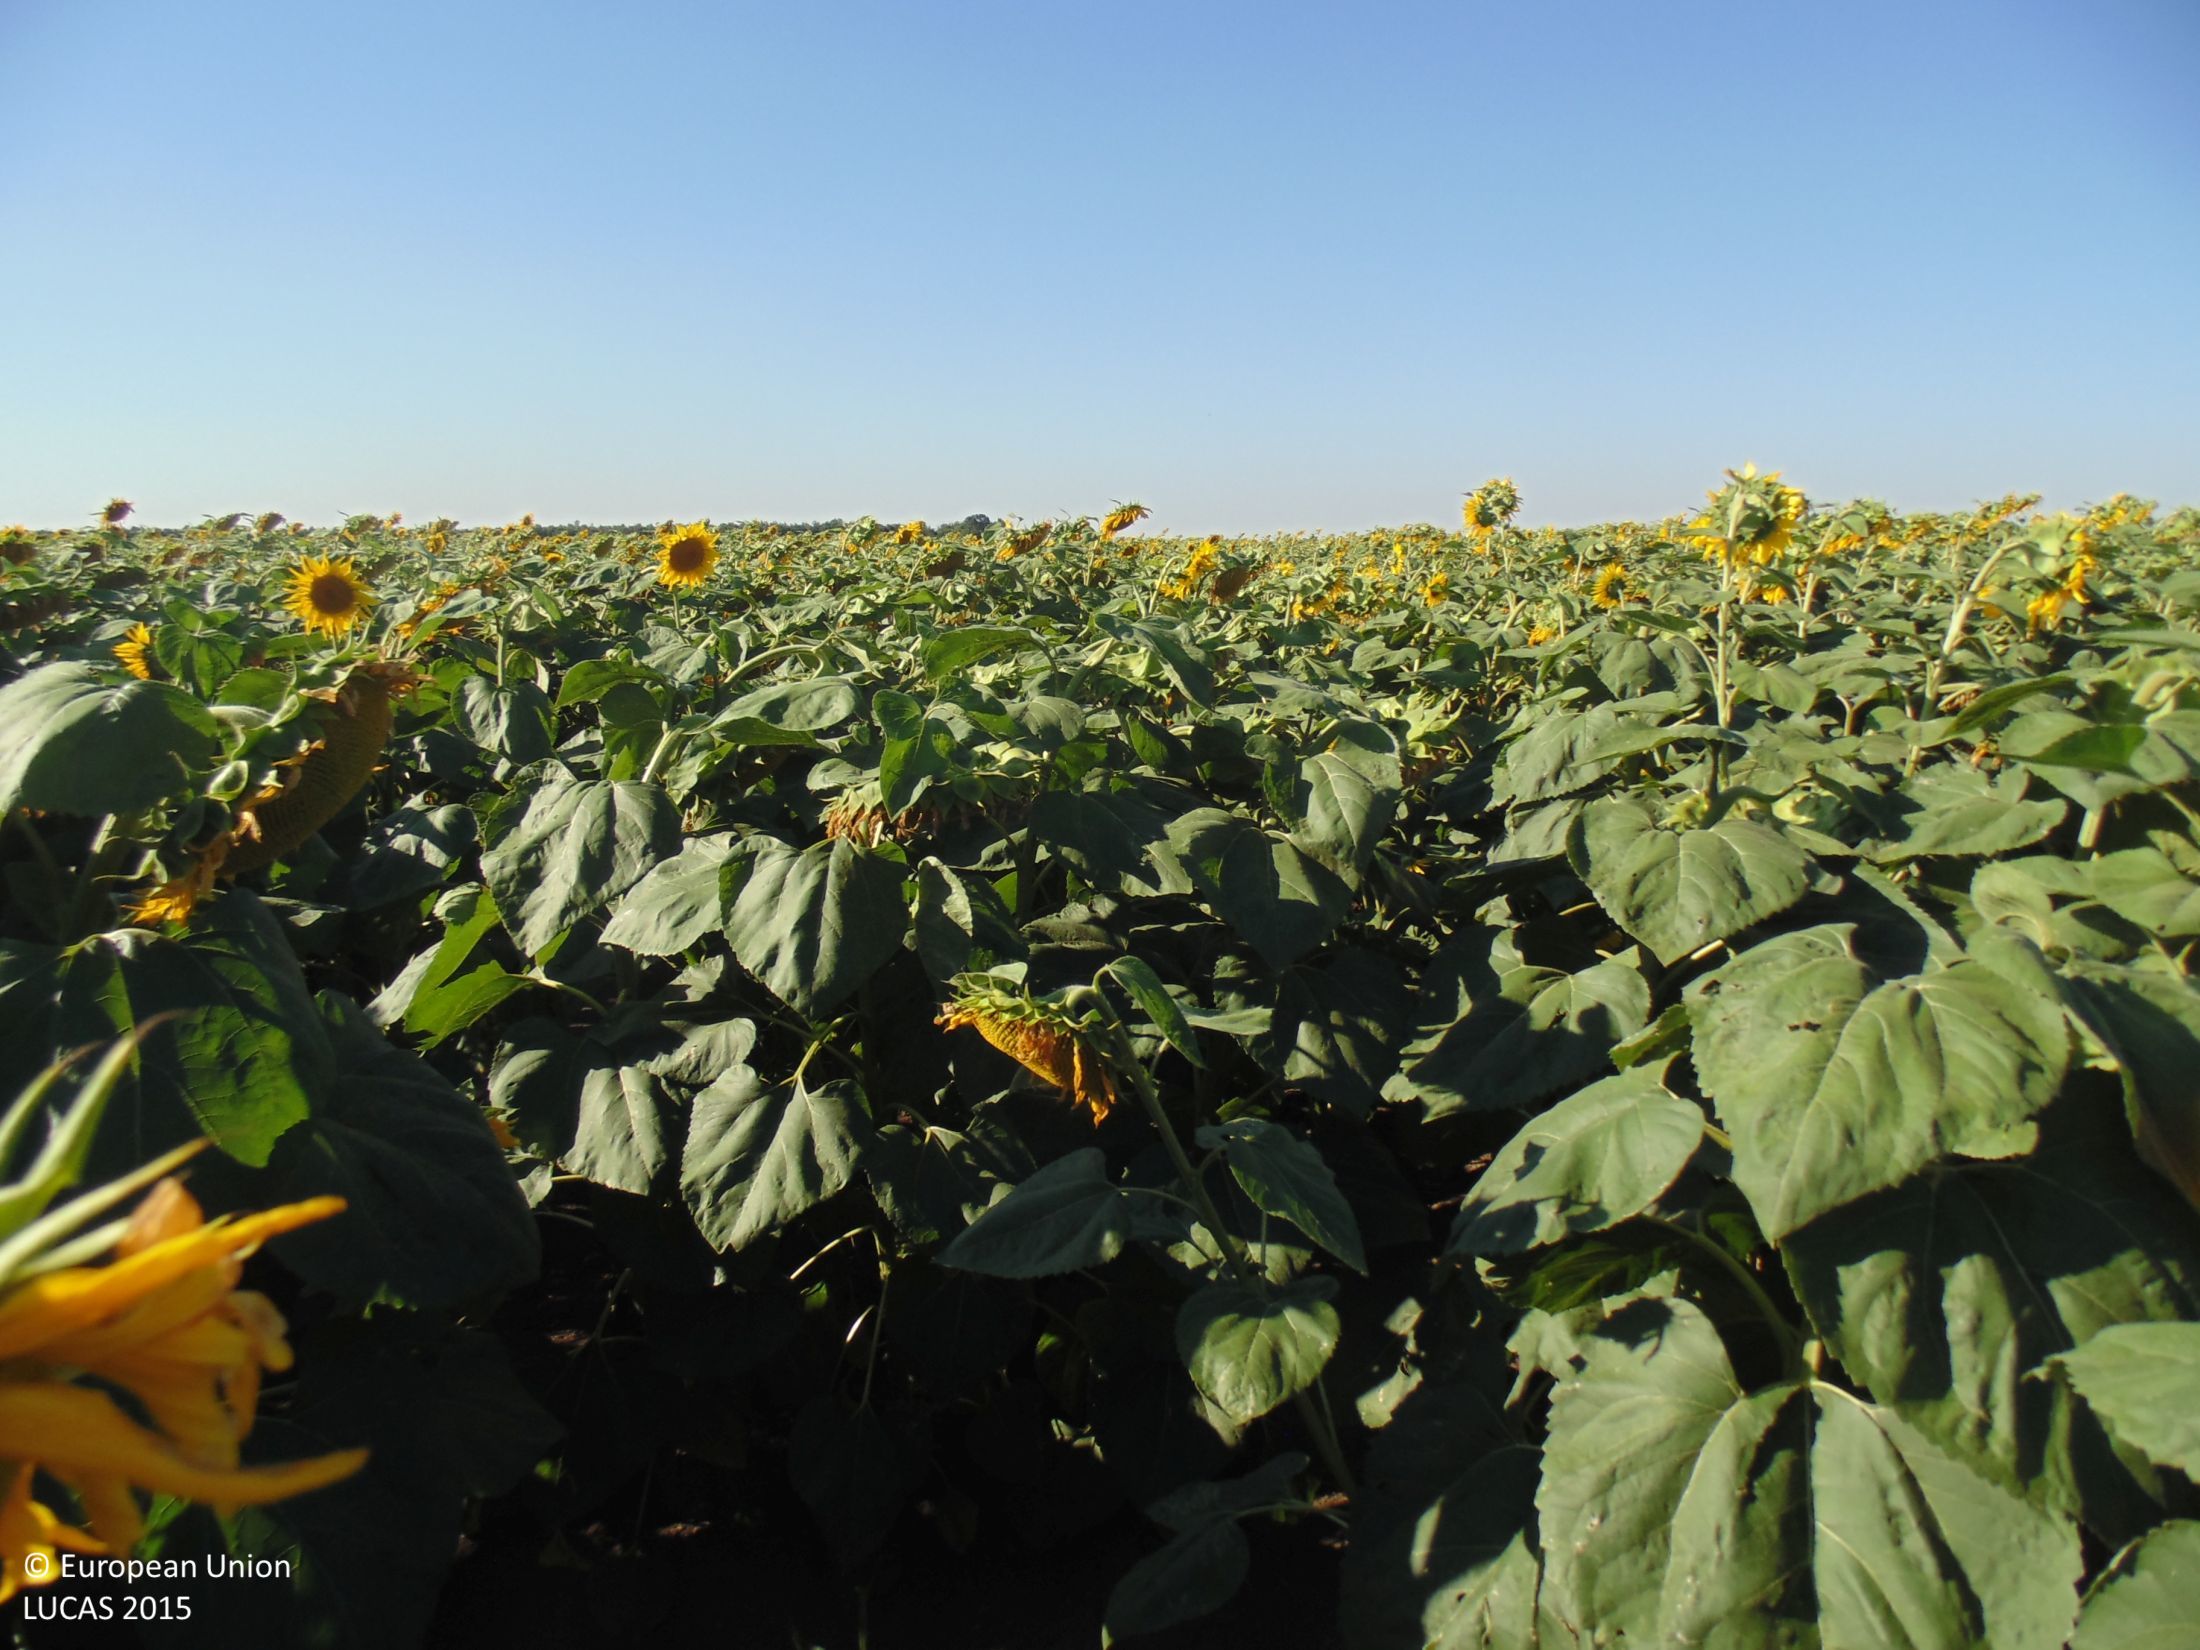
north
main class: Cropland
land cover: Sunflower
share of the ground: > 75 %
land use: Agriculture (excluding fallow land and kitchen gardens)
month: July
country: BG
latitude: 43.4520
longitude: 28.0528
